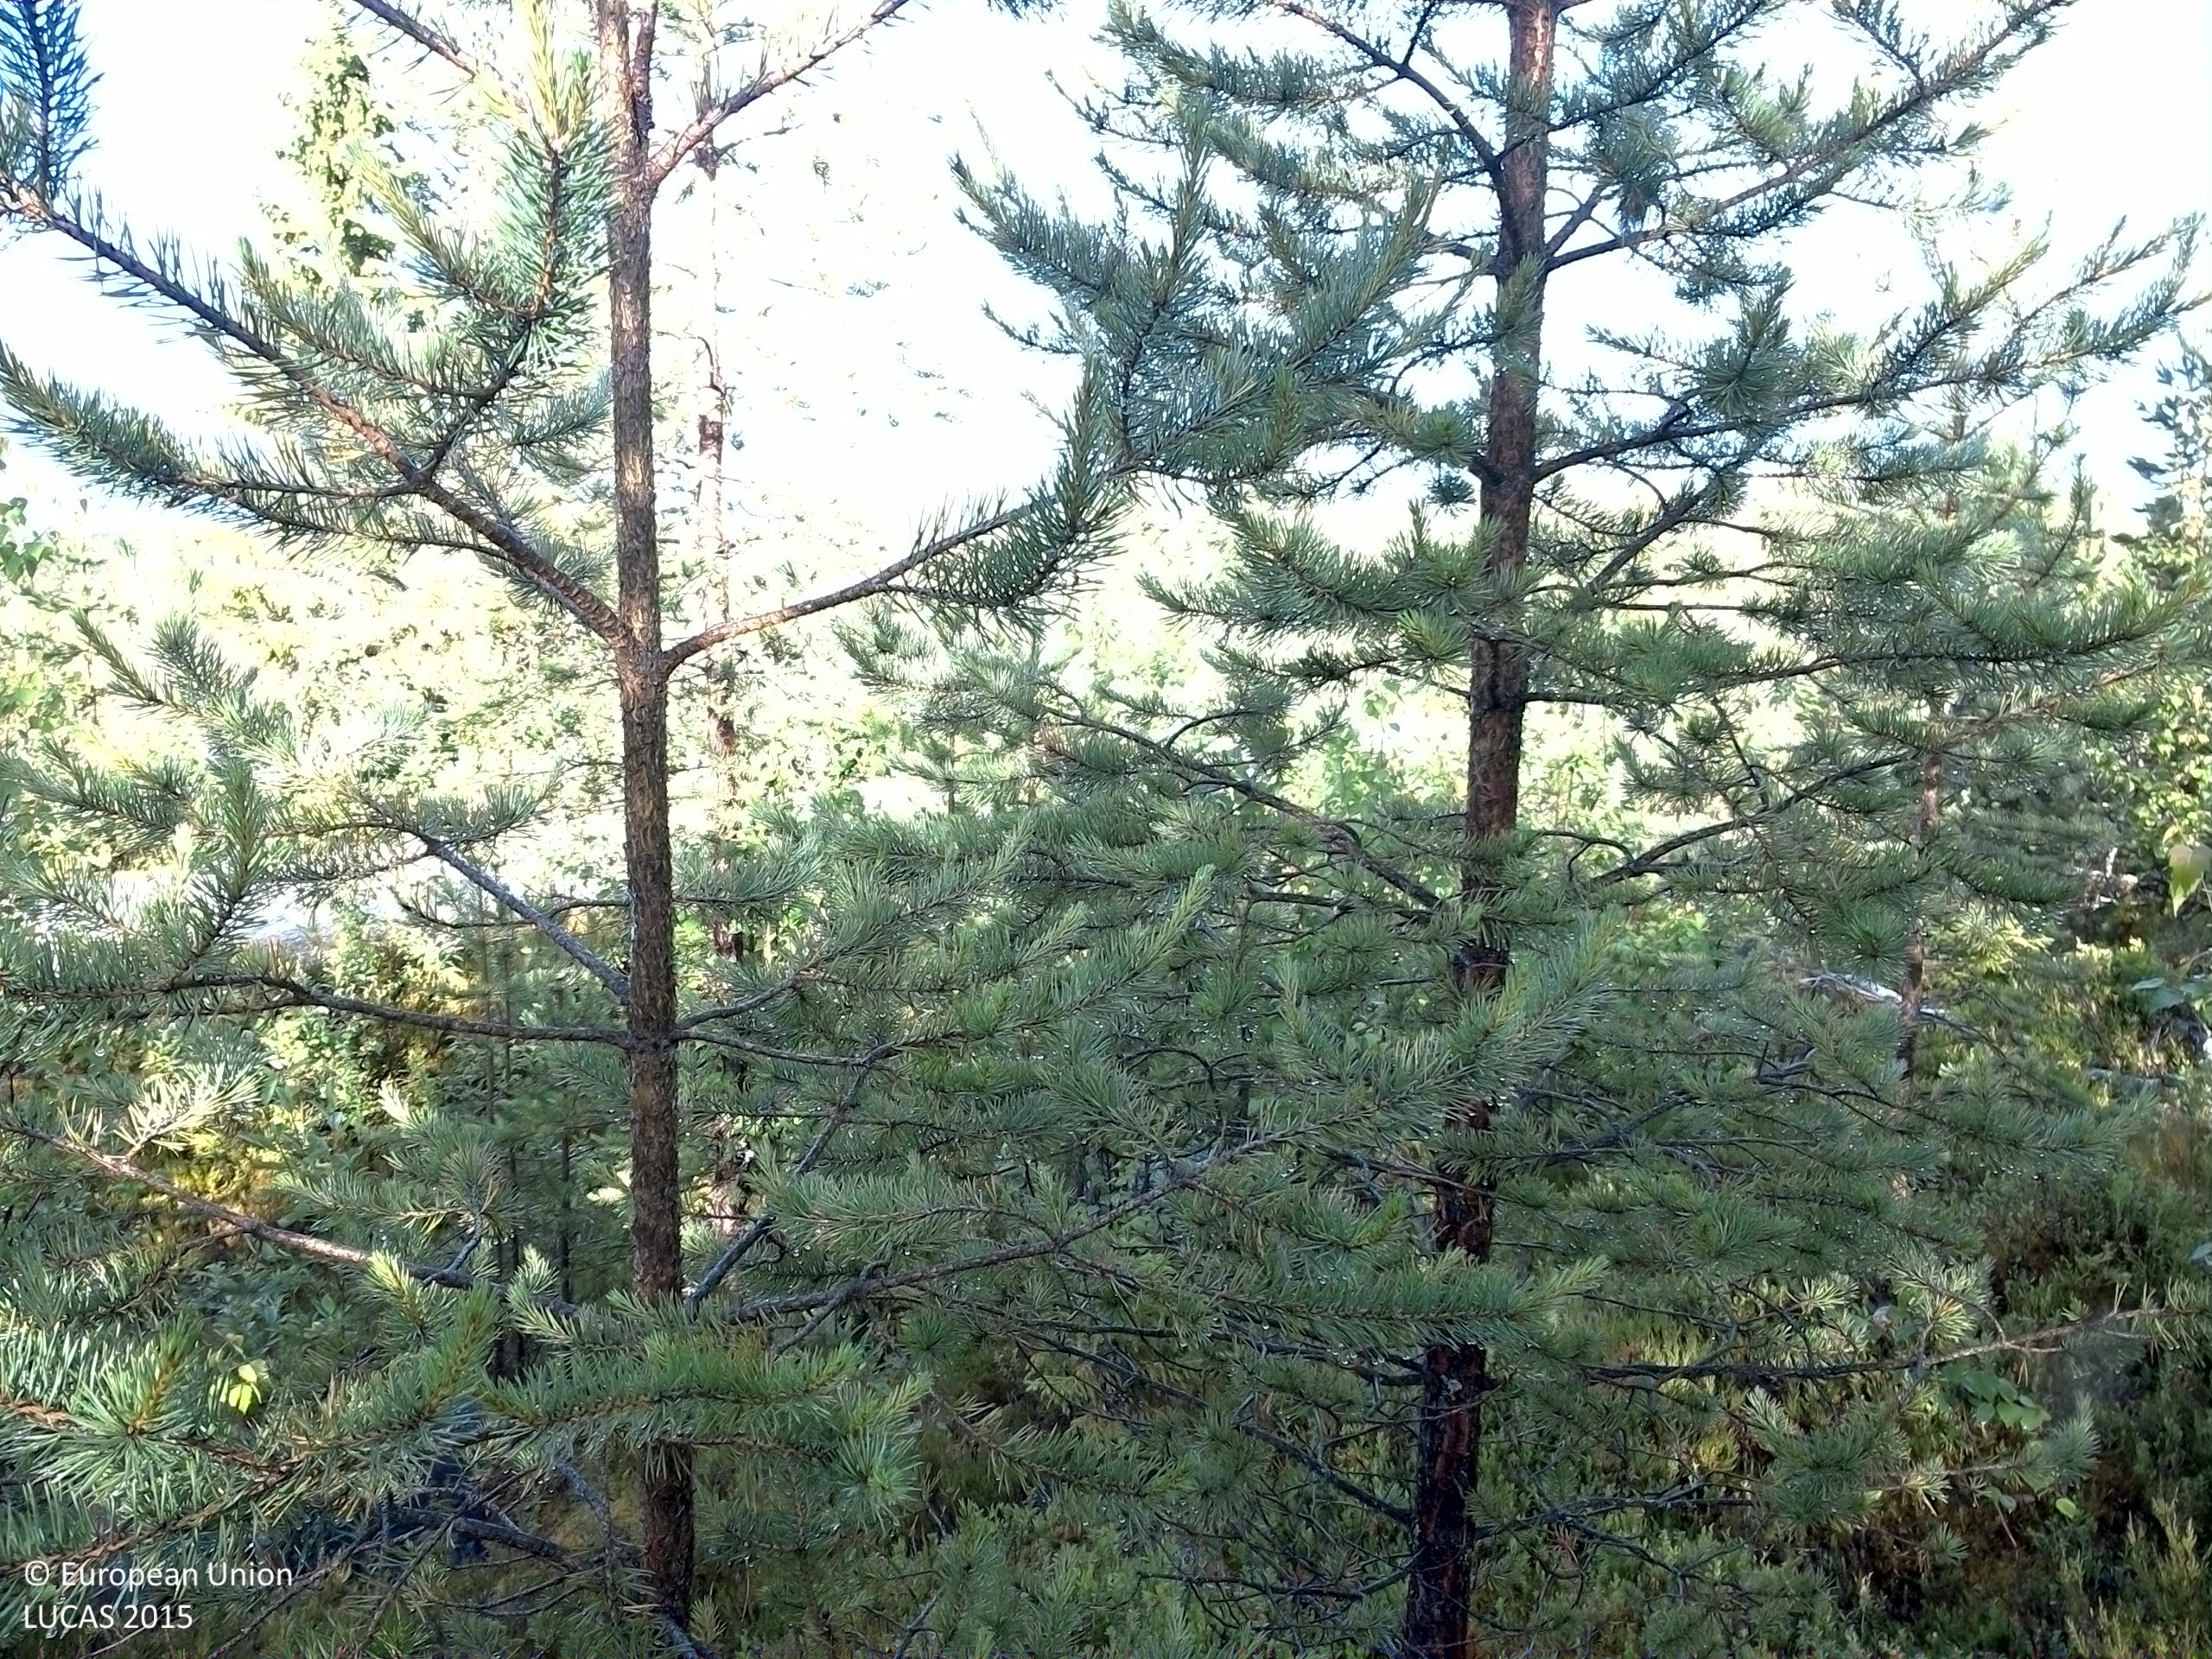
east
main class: Woodland
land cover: Pine dominated coniferous woodland
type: boreal forest
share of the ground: 25 - 50 %
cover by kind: coniferous forest trees 40 %, shrubs 35 %, lichens and mosses 15 %, broadleaved forest trees 5 %, consolidated bare surface 5 %
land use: Forestry
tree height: < 5 m
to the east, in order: Pine dominated coniferous woodland; Ditches and canals; Shruby margins; Paved roads, cycling and walking lanes; Shruby margins; Artificial constructions; Pine dominated mixed woodland; Spruce dominated mixed woodland; Rivers and streams; Spruce dominated mixed woodland
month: July
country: SE
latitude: 63.8022
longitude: 17.1386
